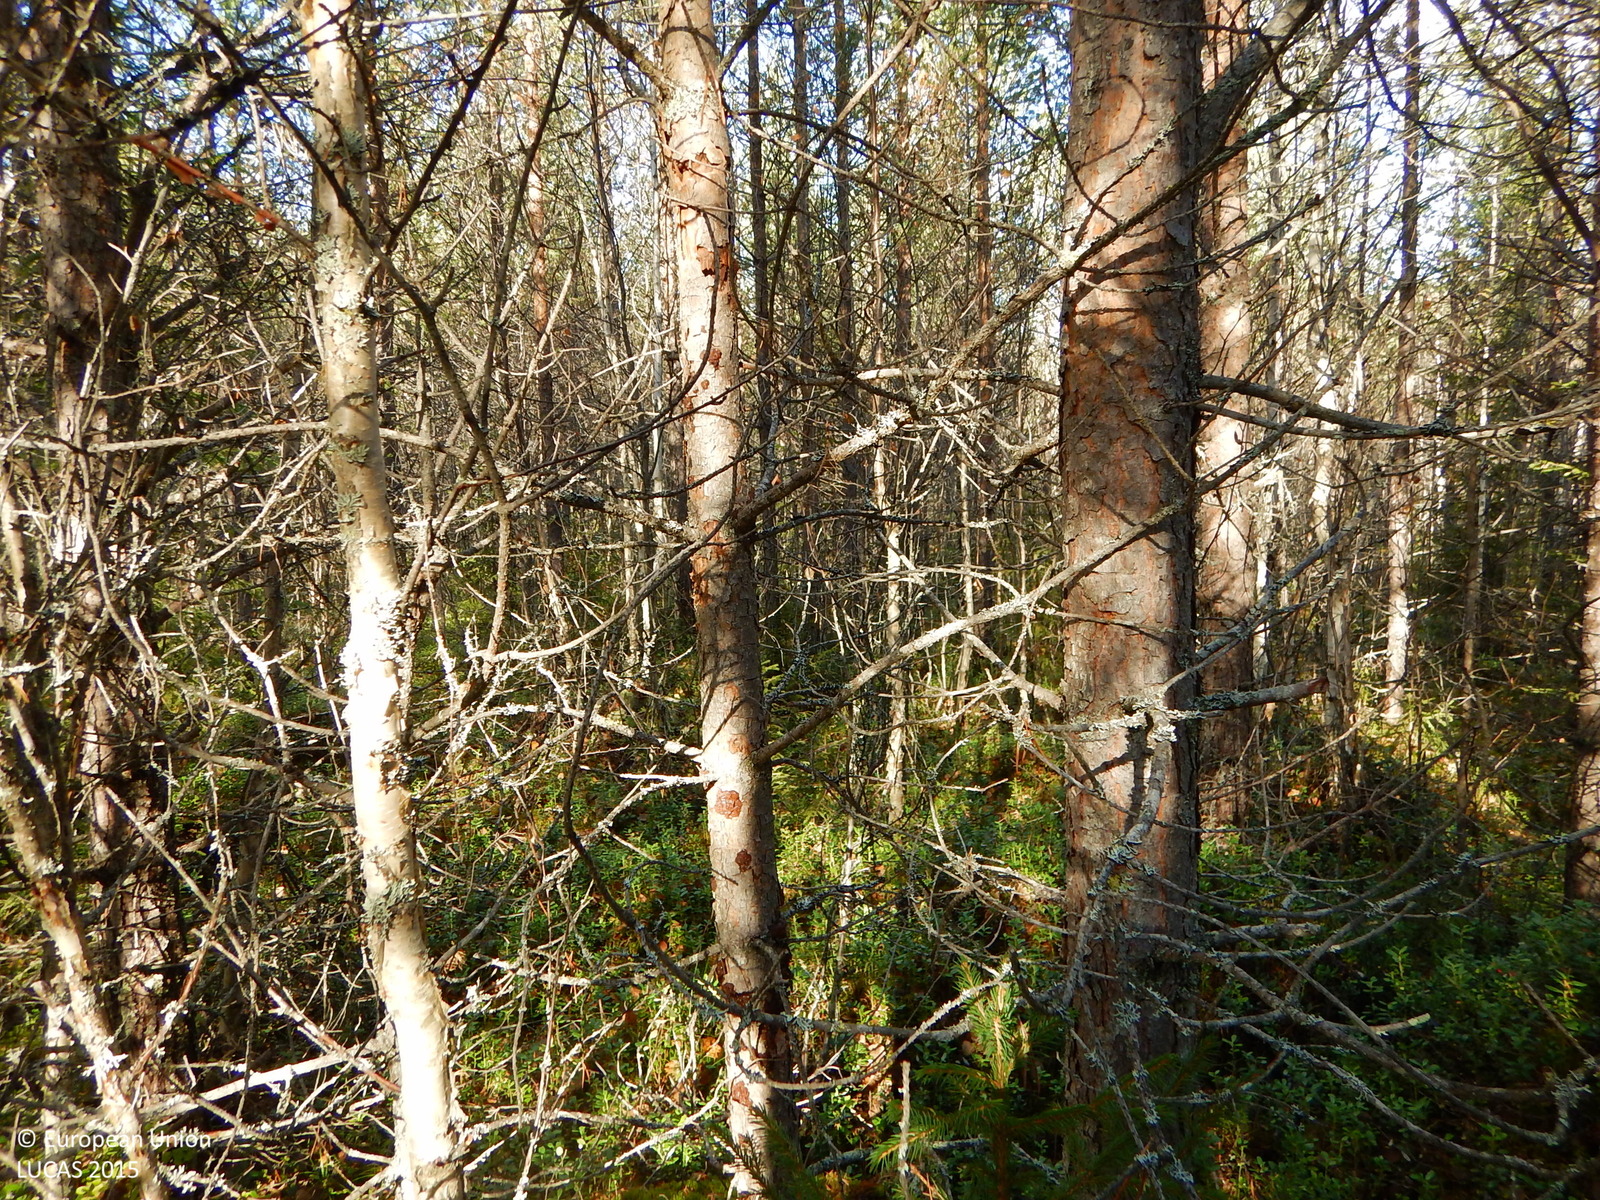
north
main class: Woodland
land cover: Pine dominated mixed woodland
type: boreal forest
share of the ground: 50 - 75 %
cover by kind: coniferous forest trees 50 %, broadleaved forest trees 20 %, shrubs 15 %, herbaceous plants 15 %
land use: Forestry
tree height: > 5 m
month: September
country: SE
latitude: 64.9299
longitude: 20.1445
